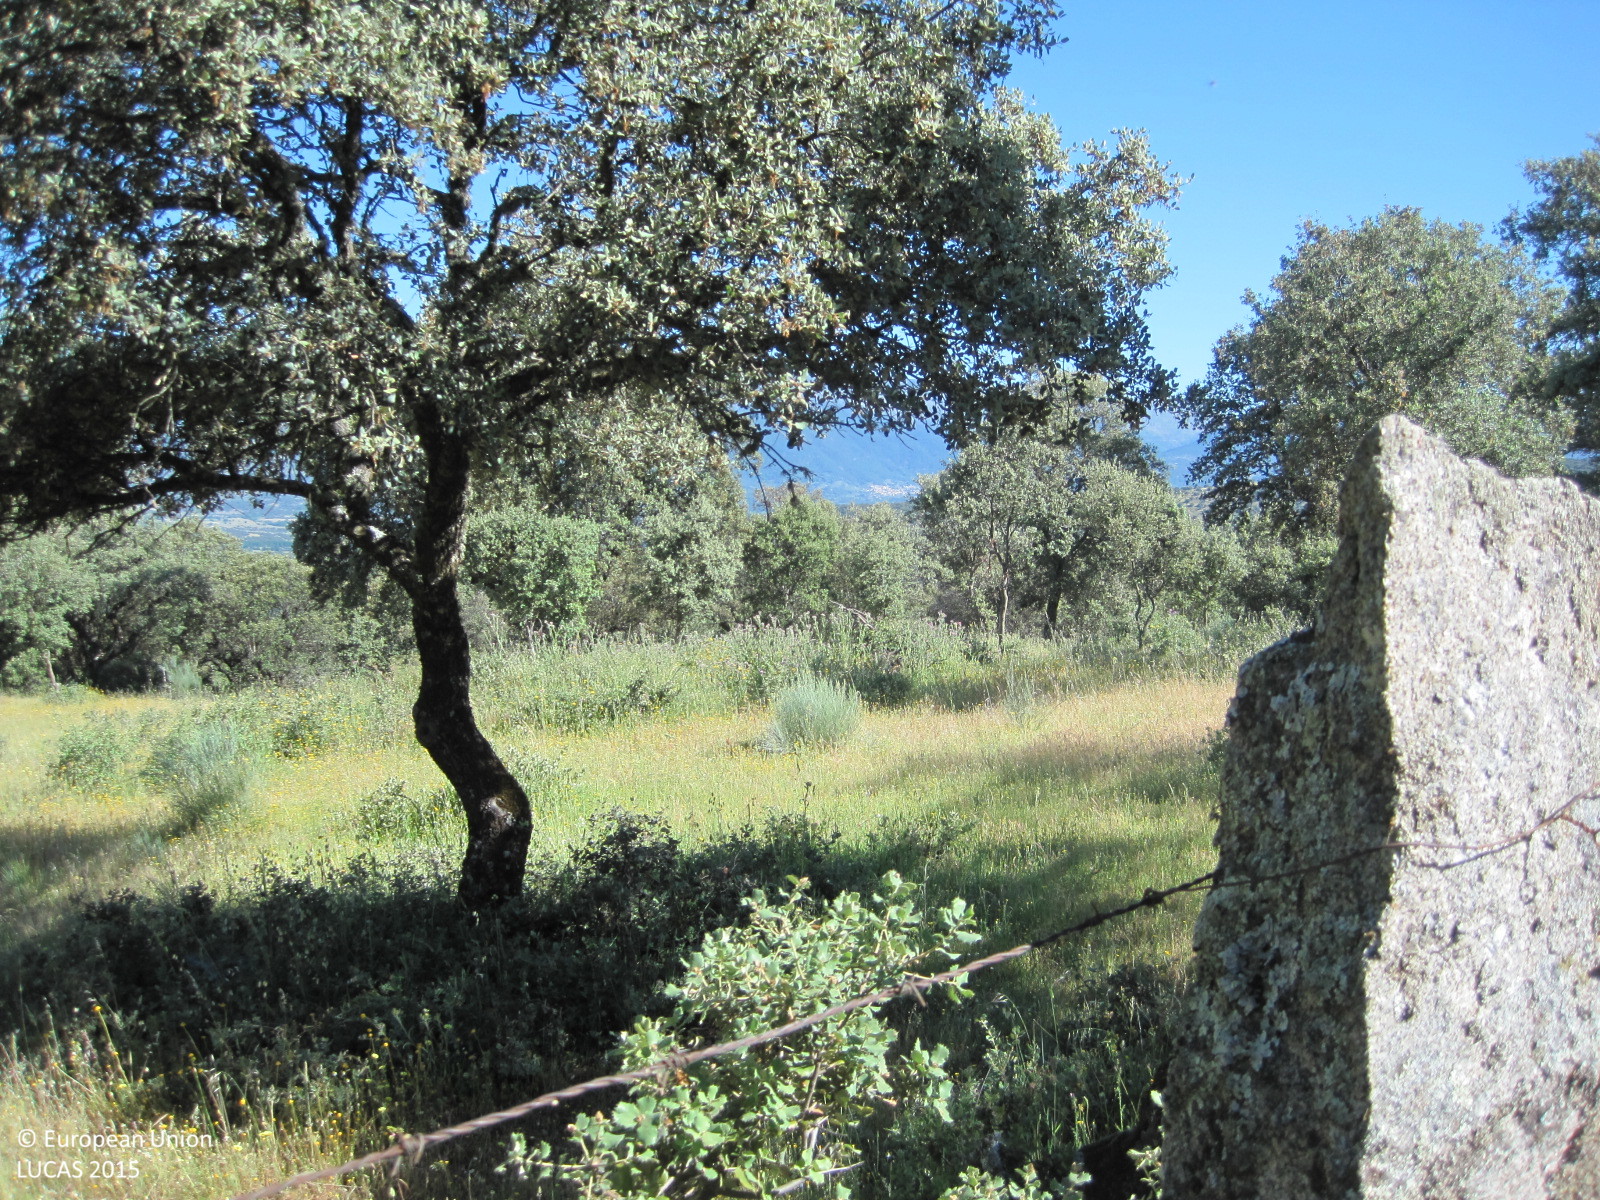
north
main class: Woodland
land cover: Broadleaved woodland
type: broadleaved evergreen forest
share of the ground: > 75 %
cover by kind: shrubs 85 %, broadleaved forest trees 15 %
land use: Semi-natural and natural areas not in use
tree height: > 5 m
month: May
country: ES
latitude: 40.1609
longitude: -4.8325
